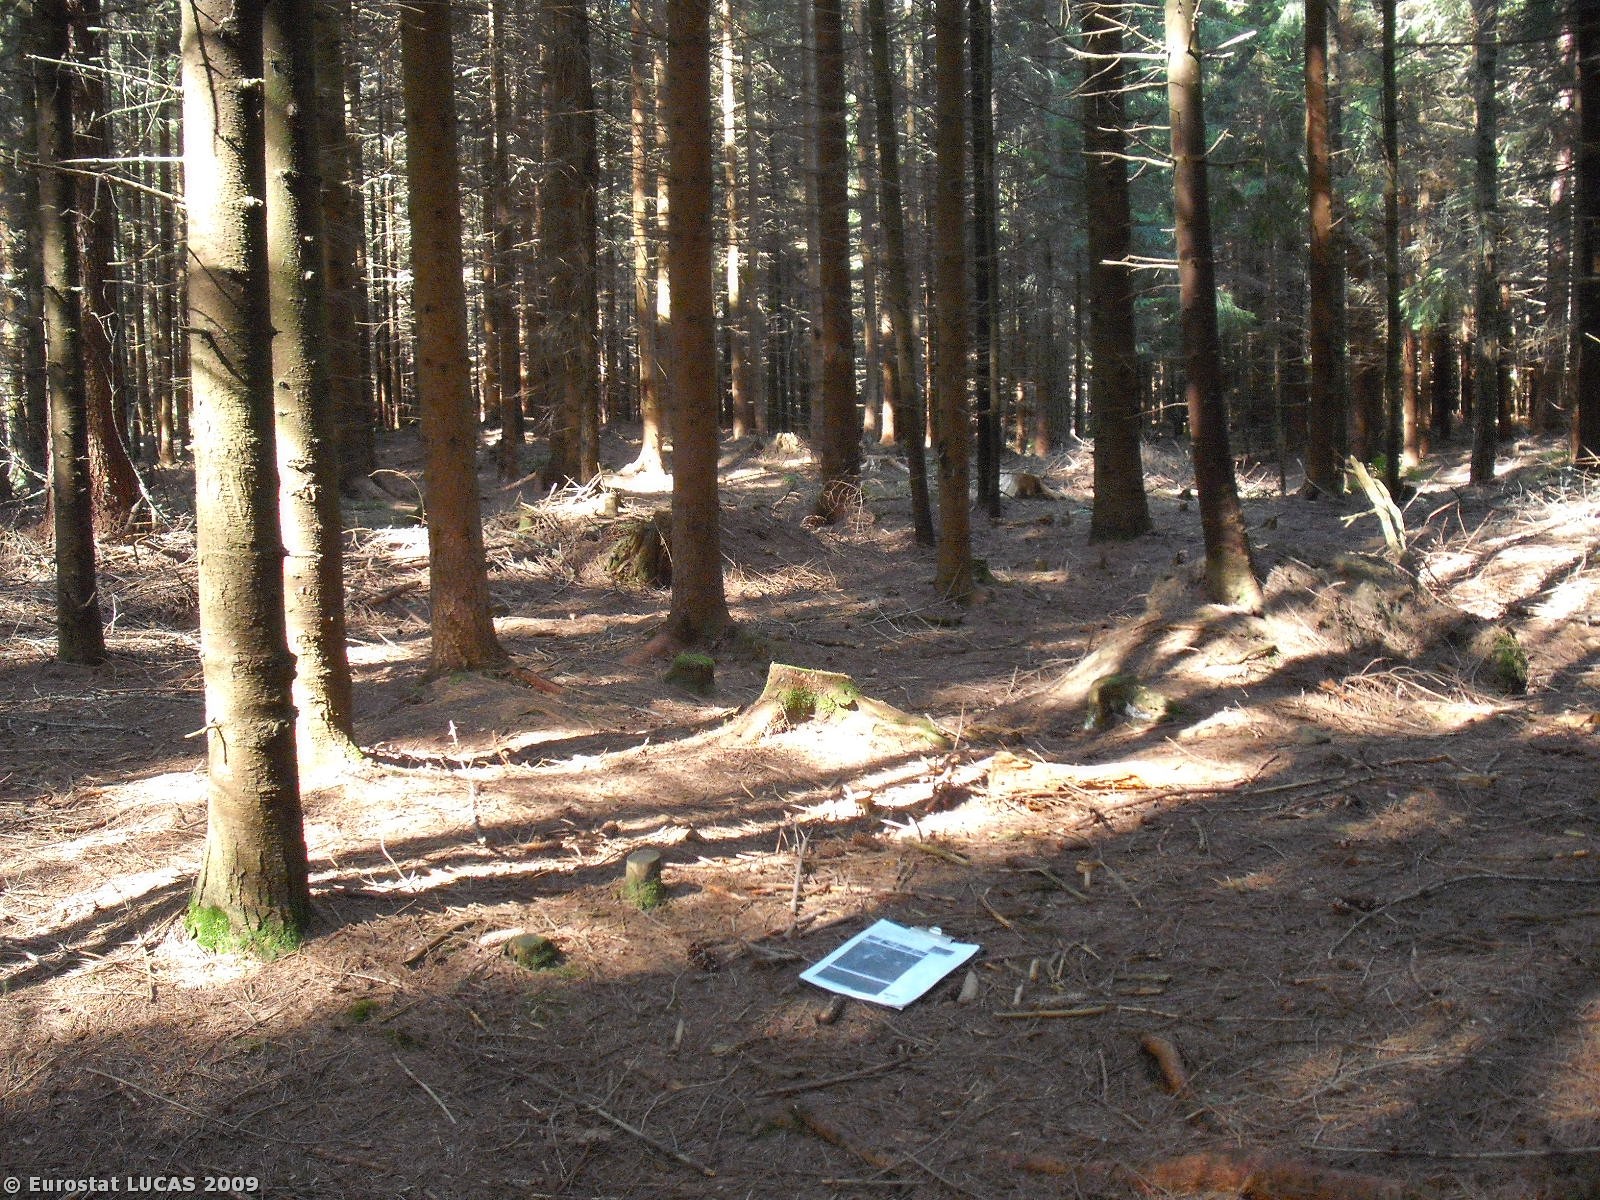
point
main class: Woodland
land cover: Coniferous woodland
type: hemiboreal forest and nemoral coniferous forest and mixed broadleaved-coniferous forest
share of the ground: > 75 %
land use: Forestry
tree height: > 5 m
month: September
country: PL
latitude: 49.5083
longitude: 20.9664
